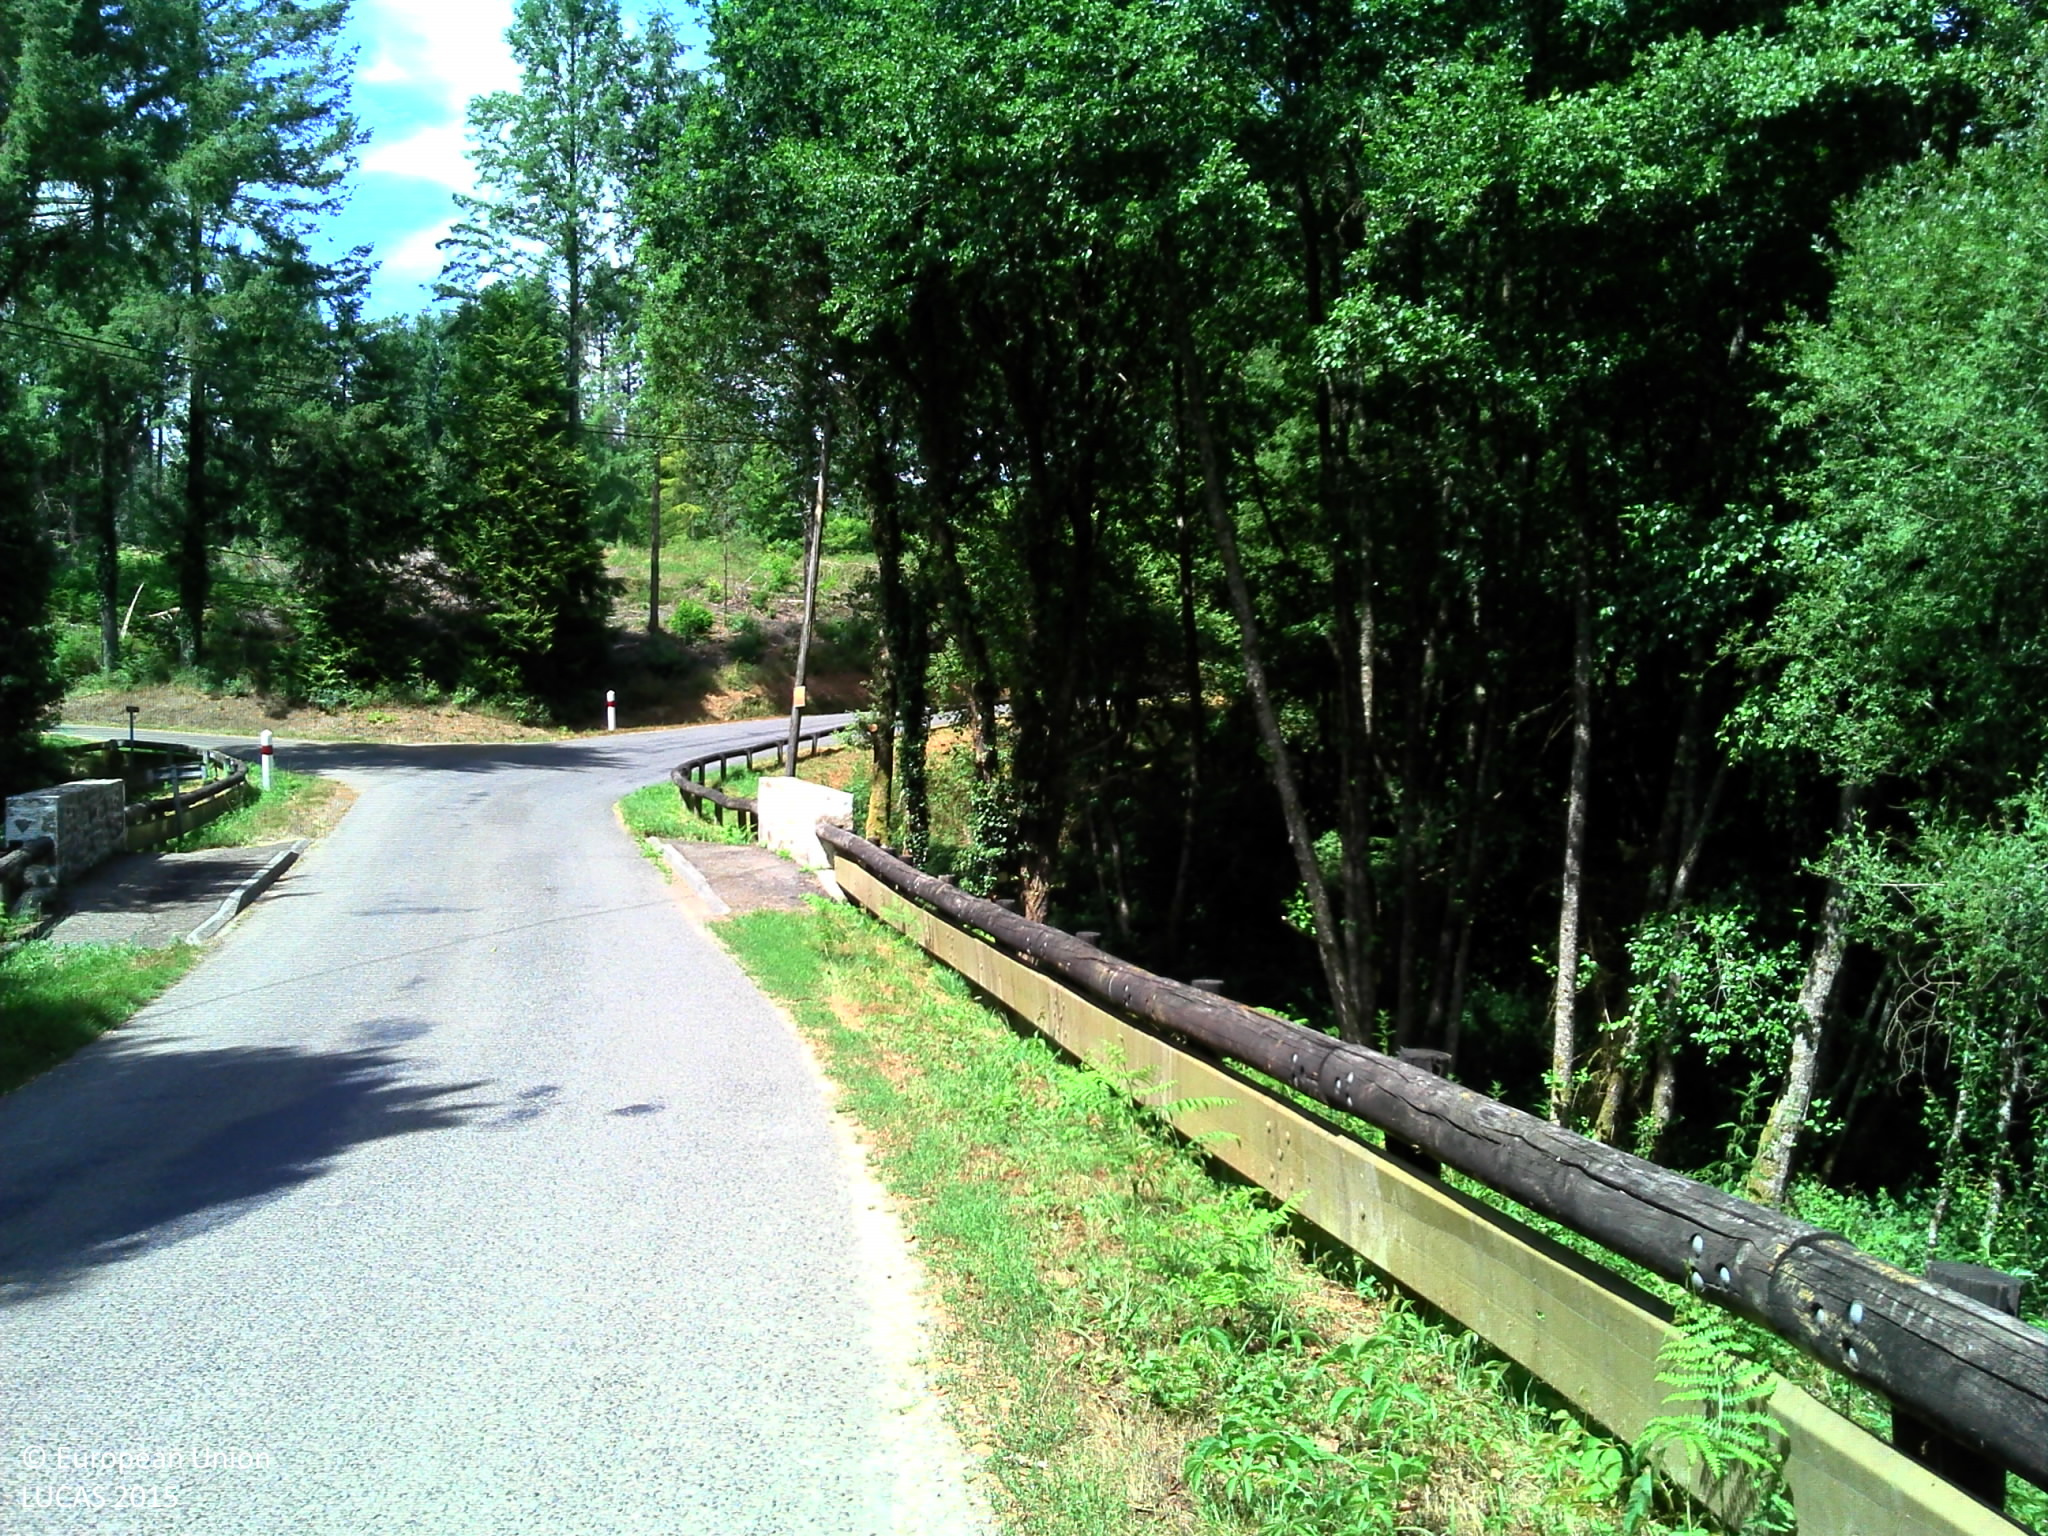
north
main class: Grassland
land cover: Spontaneously vegetated surfaces
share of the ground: > 75 %
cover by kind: herbaceous plants 95 %
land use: Semi-natural and natural areas not in use
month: July
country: FR
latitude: 45.7865
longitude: 1.6193
